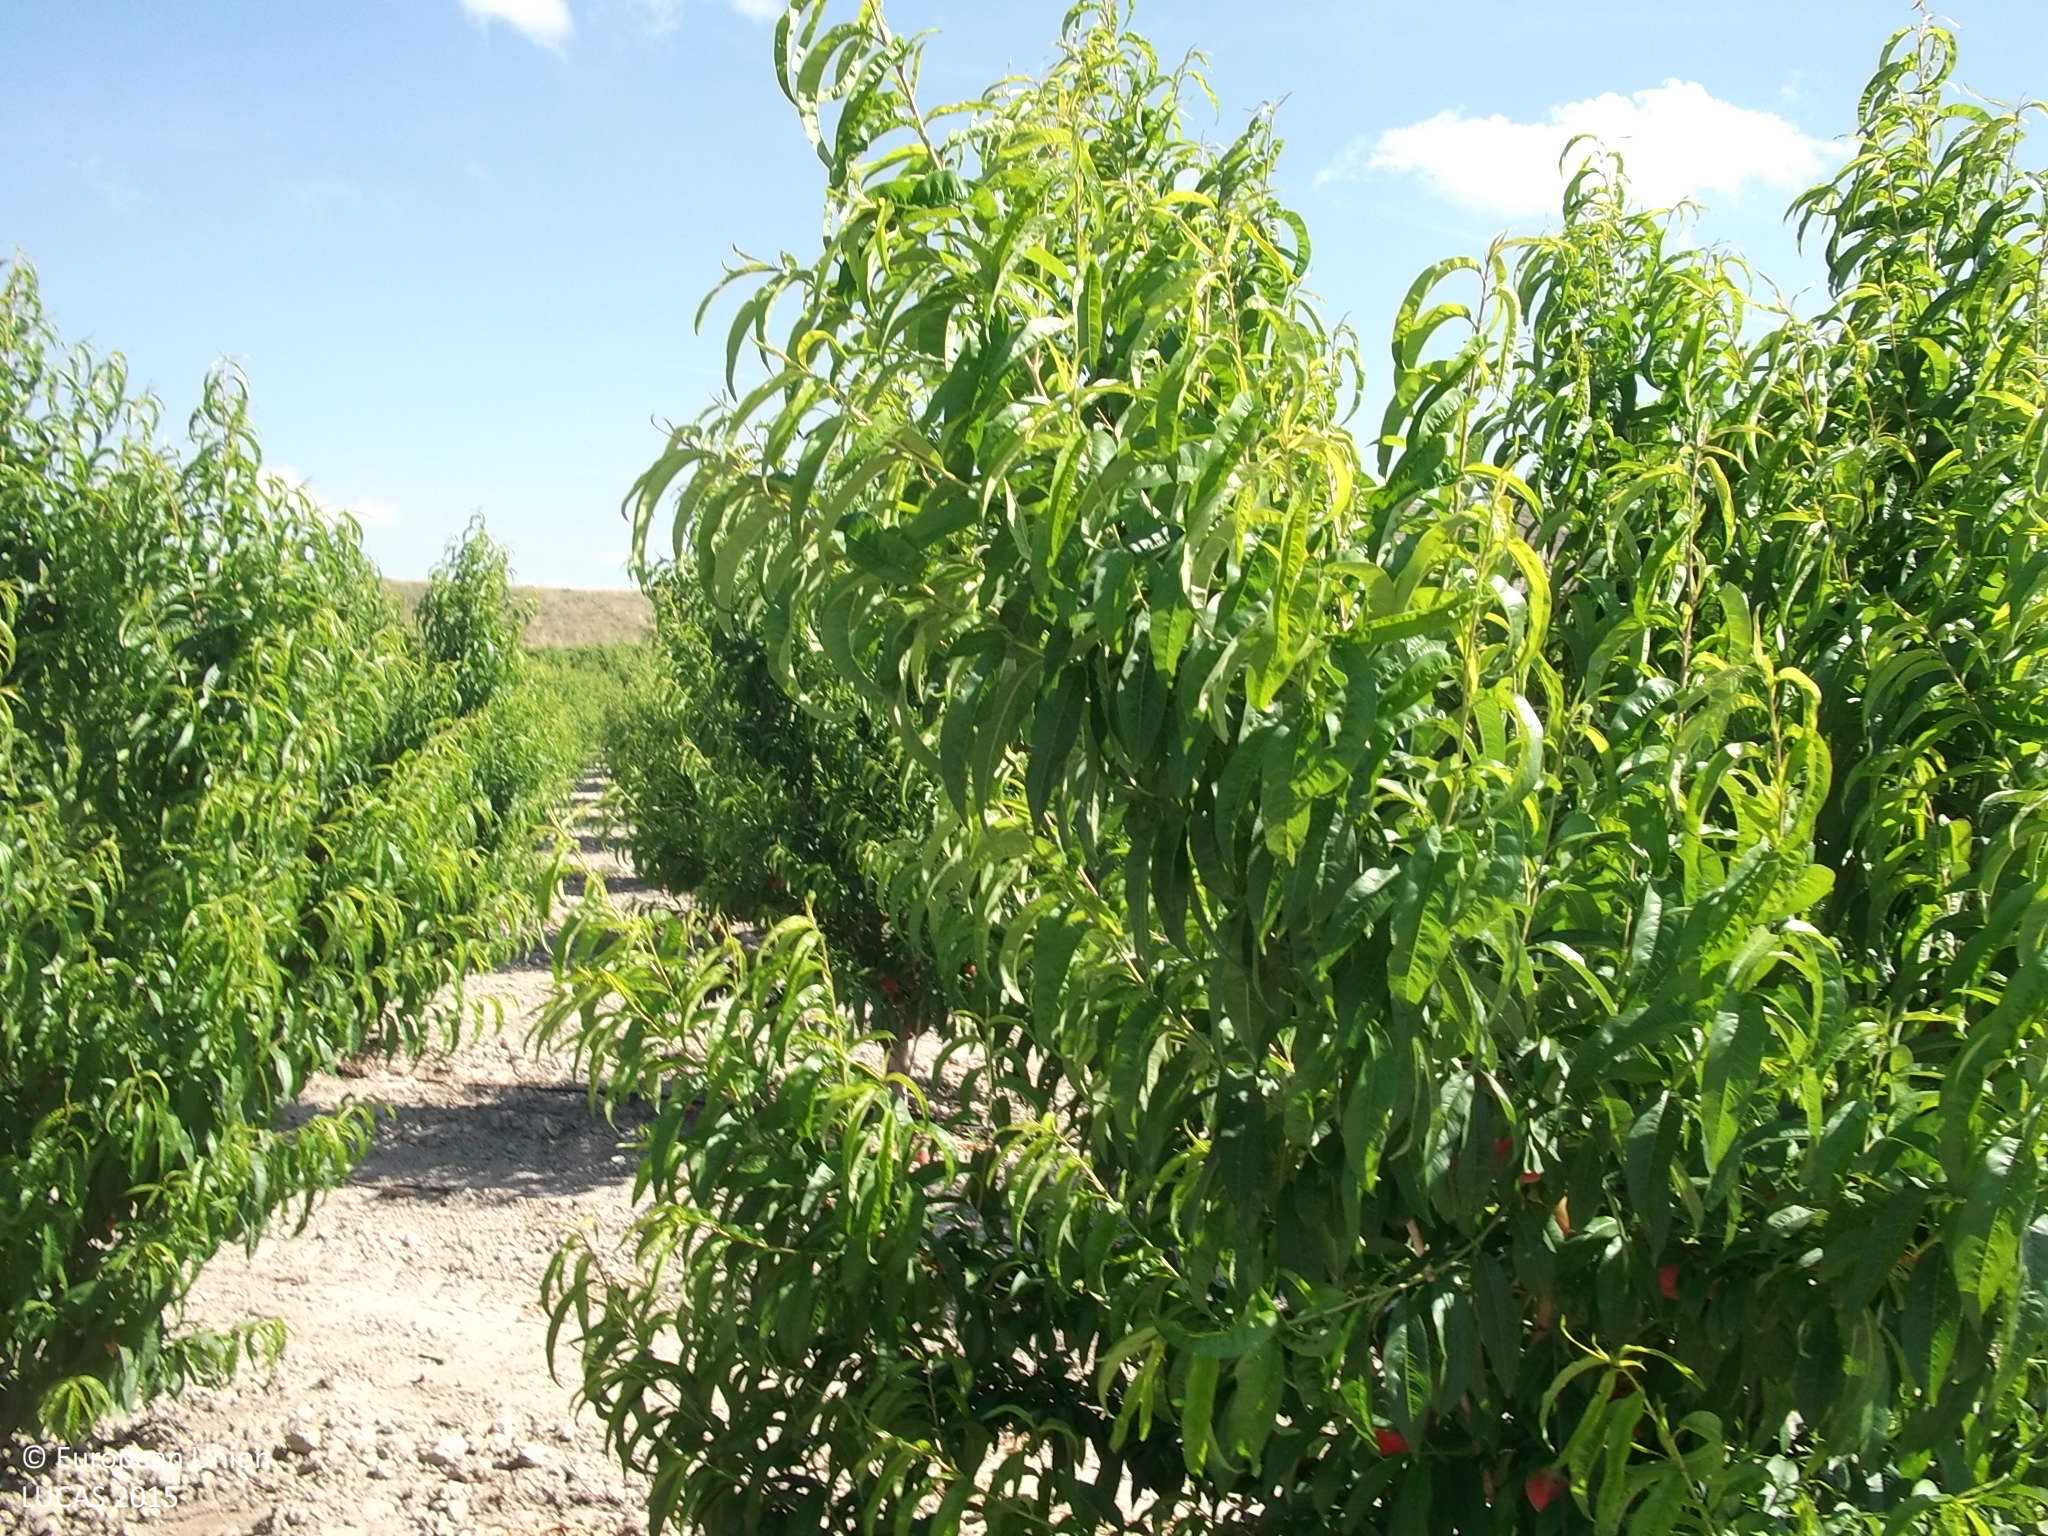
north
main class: Cropland
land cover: Other fruit trees and berries
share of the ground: 10 - 25 %
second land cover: Other bare soil
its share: > 75 %
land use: Agriculture (excluding fallow land and kitchen gardens)
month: May
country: ES
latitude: 38.3198
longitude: -1.4158
